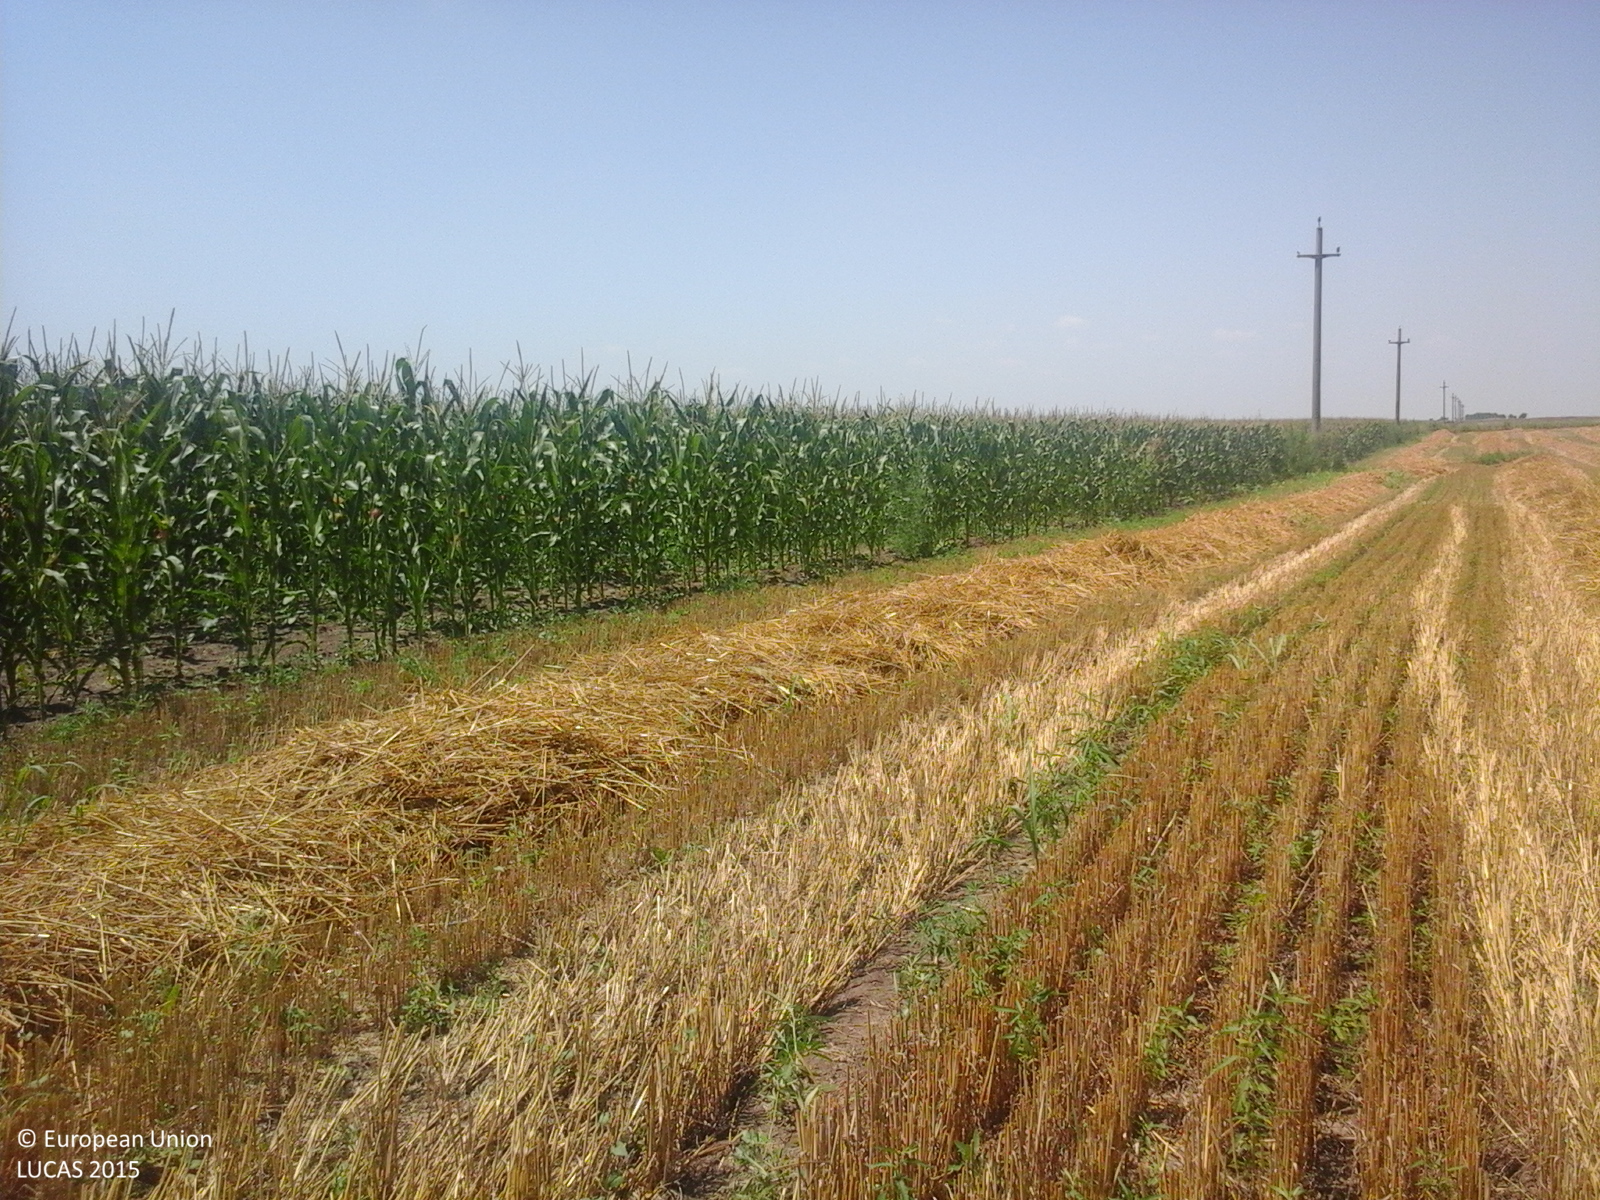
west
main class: Cropland
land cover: Common wheat
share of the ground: 50 - 75 %
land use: Agriculture (excluding fallow land and kitchen gardens)
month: July
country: RO
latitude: 44.4622
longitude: 27.1120
